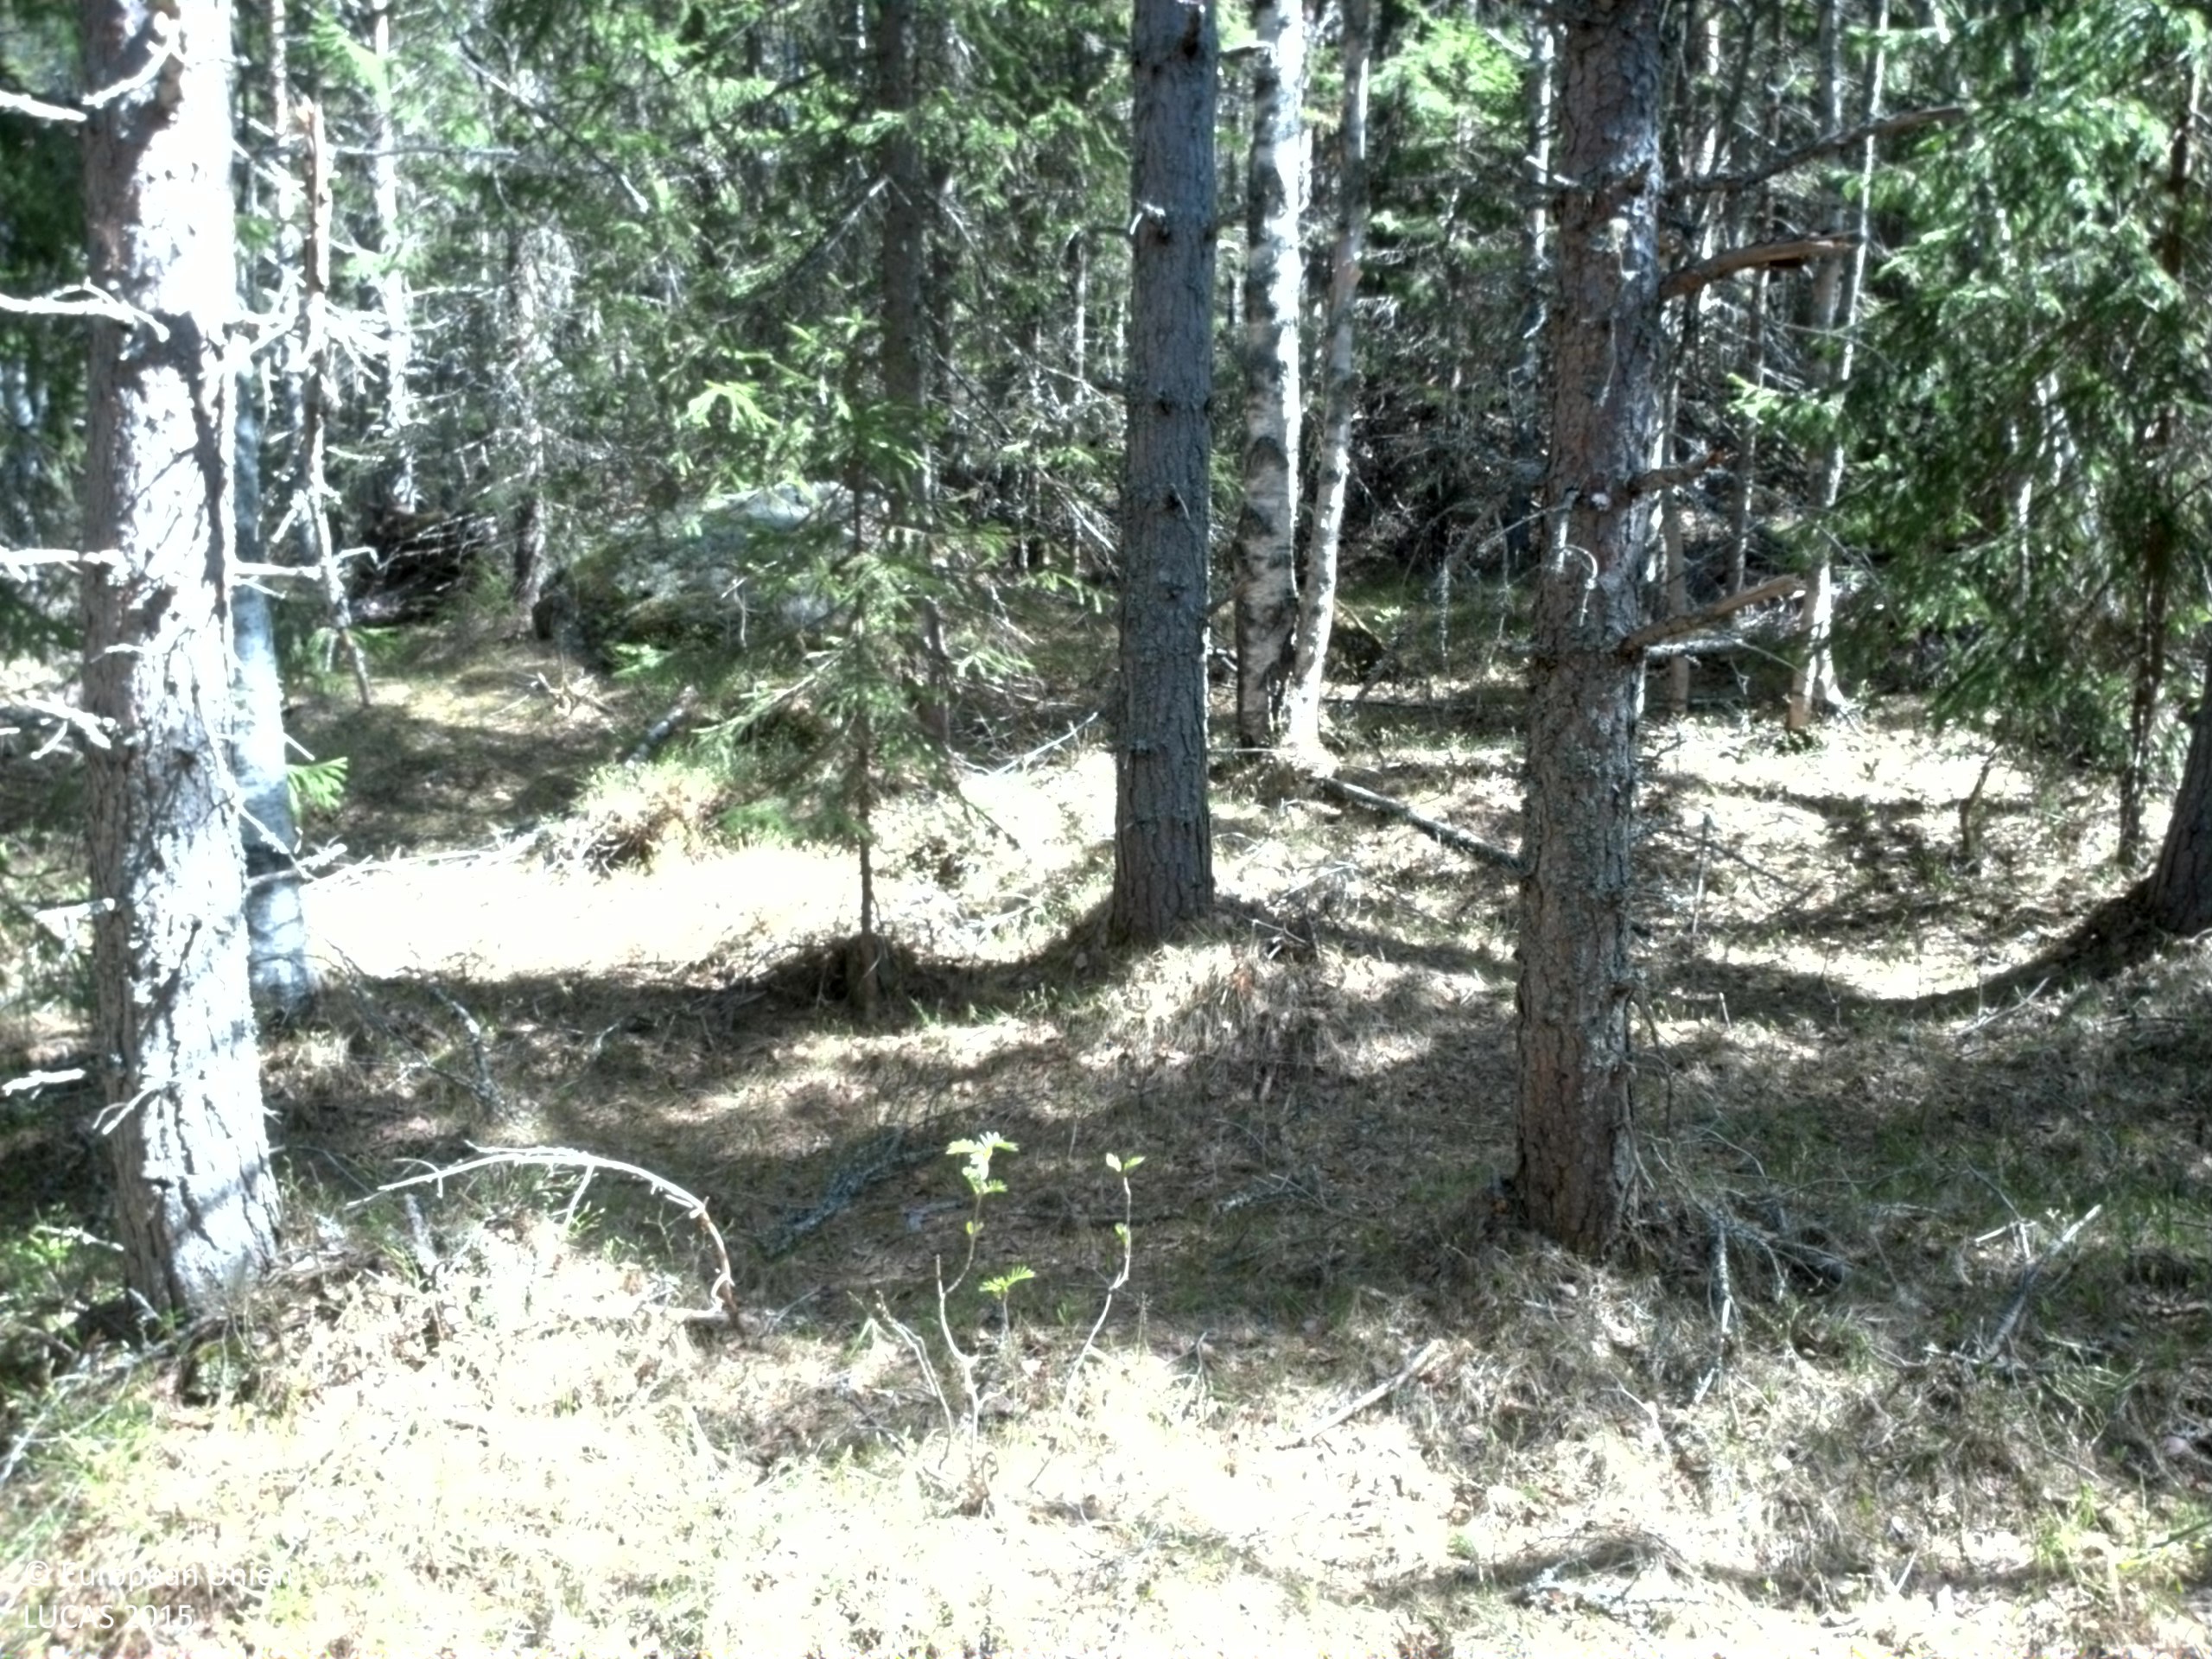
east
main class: Woodland
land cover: Pine dominated mixed woodland
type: boreal forest
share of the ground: > 75 %
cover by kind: coniferous forest trees 60 %, broadleaved forest trees 20 %, herbaceous plants 20 %
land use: Forestry
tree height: > 5 m
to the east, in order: Pine dominated mixed woodland; Other bare soil; Paved roads, cycling and walking lanes; Other mixed woodland; Pine dominated mixed woodland
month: May
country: SE
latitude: 63.1048
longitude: 18.0421
